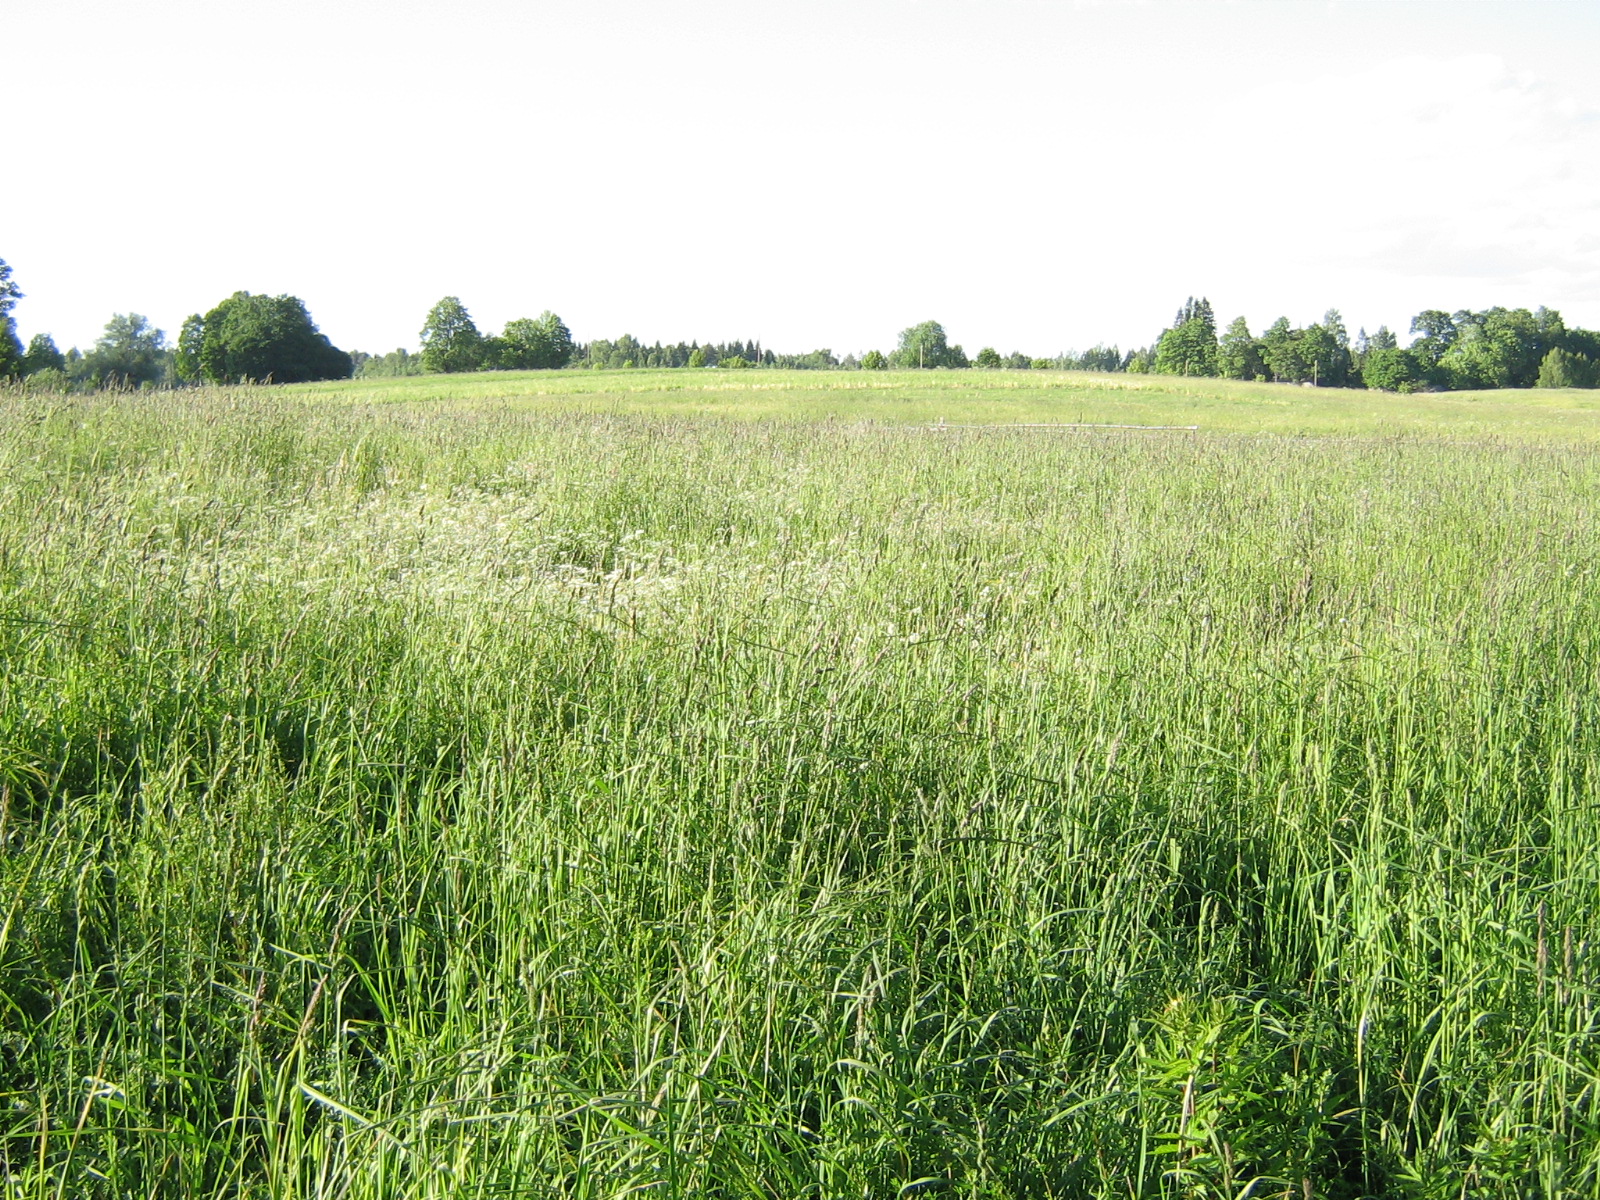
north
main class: Grassland
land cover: Grassland without tree/shrub cover
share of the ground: > 75 %
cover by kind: herbaceous plants 100 %
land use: Agriculture (excluding fallow land and kitchen gardens)
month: June
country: LV
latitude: 57.1555
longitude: 25.8818
